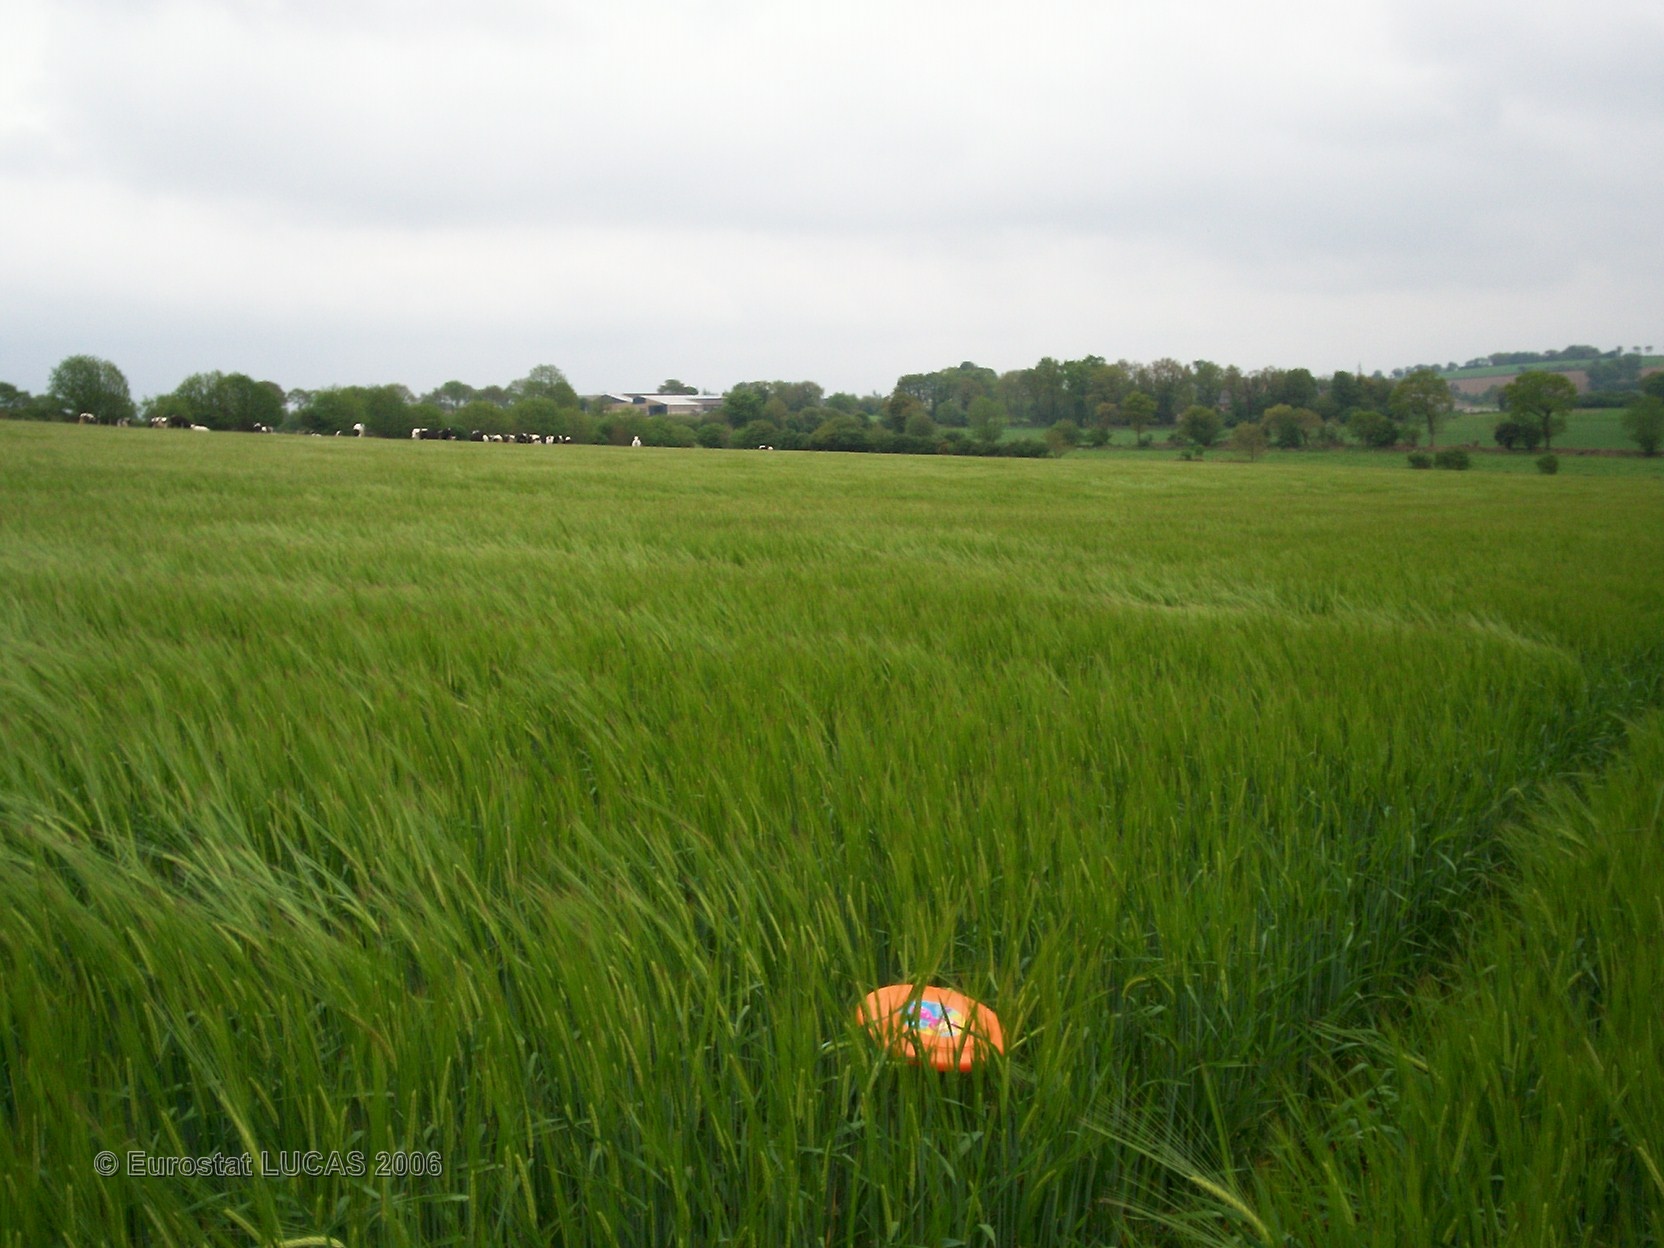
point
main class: Cropland
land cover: Barley
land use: Agriculture (excluding fallow land and kitchen gardens)
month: May
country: FR
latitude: 48.2575
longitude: -3.6994
